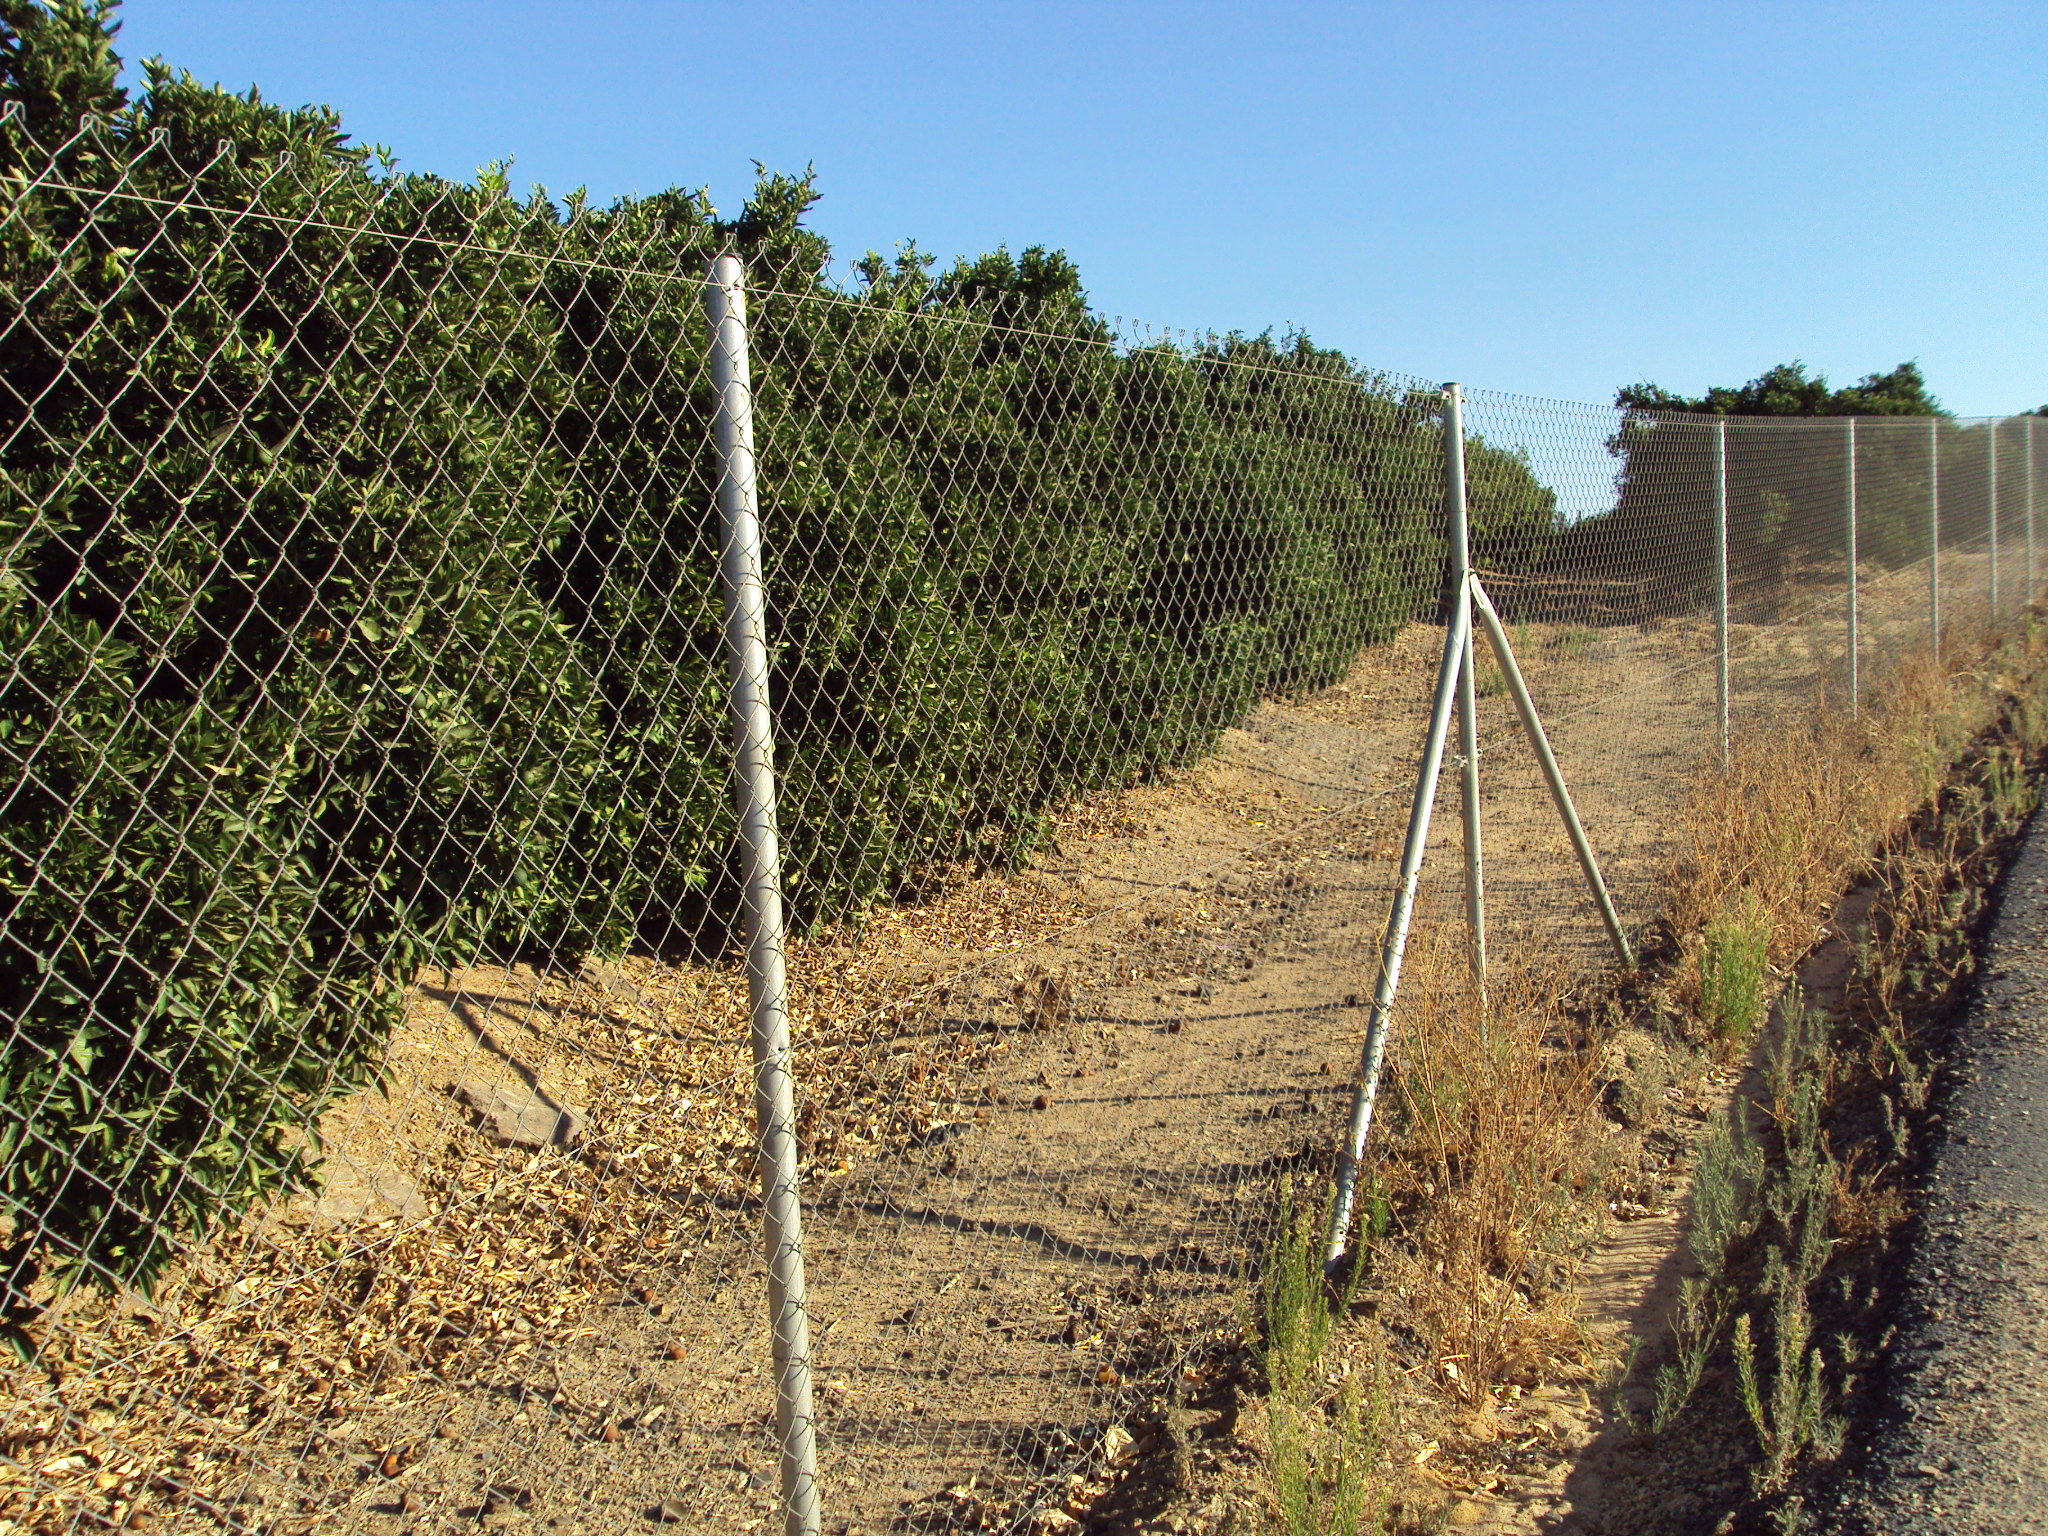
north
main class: Cropland
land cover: Oranges
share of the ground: > 75 %
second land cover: Other bare soil
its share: > 75 %
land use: Agriculture (excluding fallow land and kitchen gardens)
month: July
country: ES
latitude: 37.4153
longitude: -7.0480
